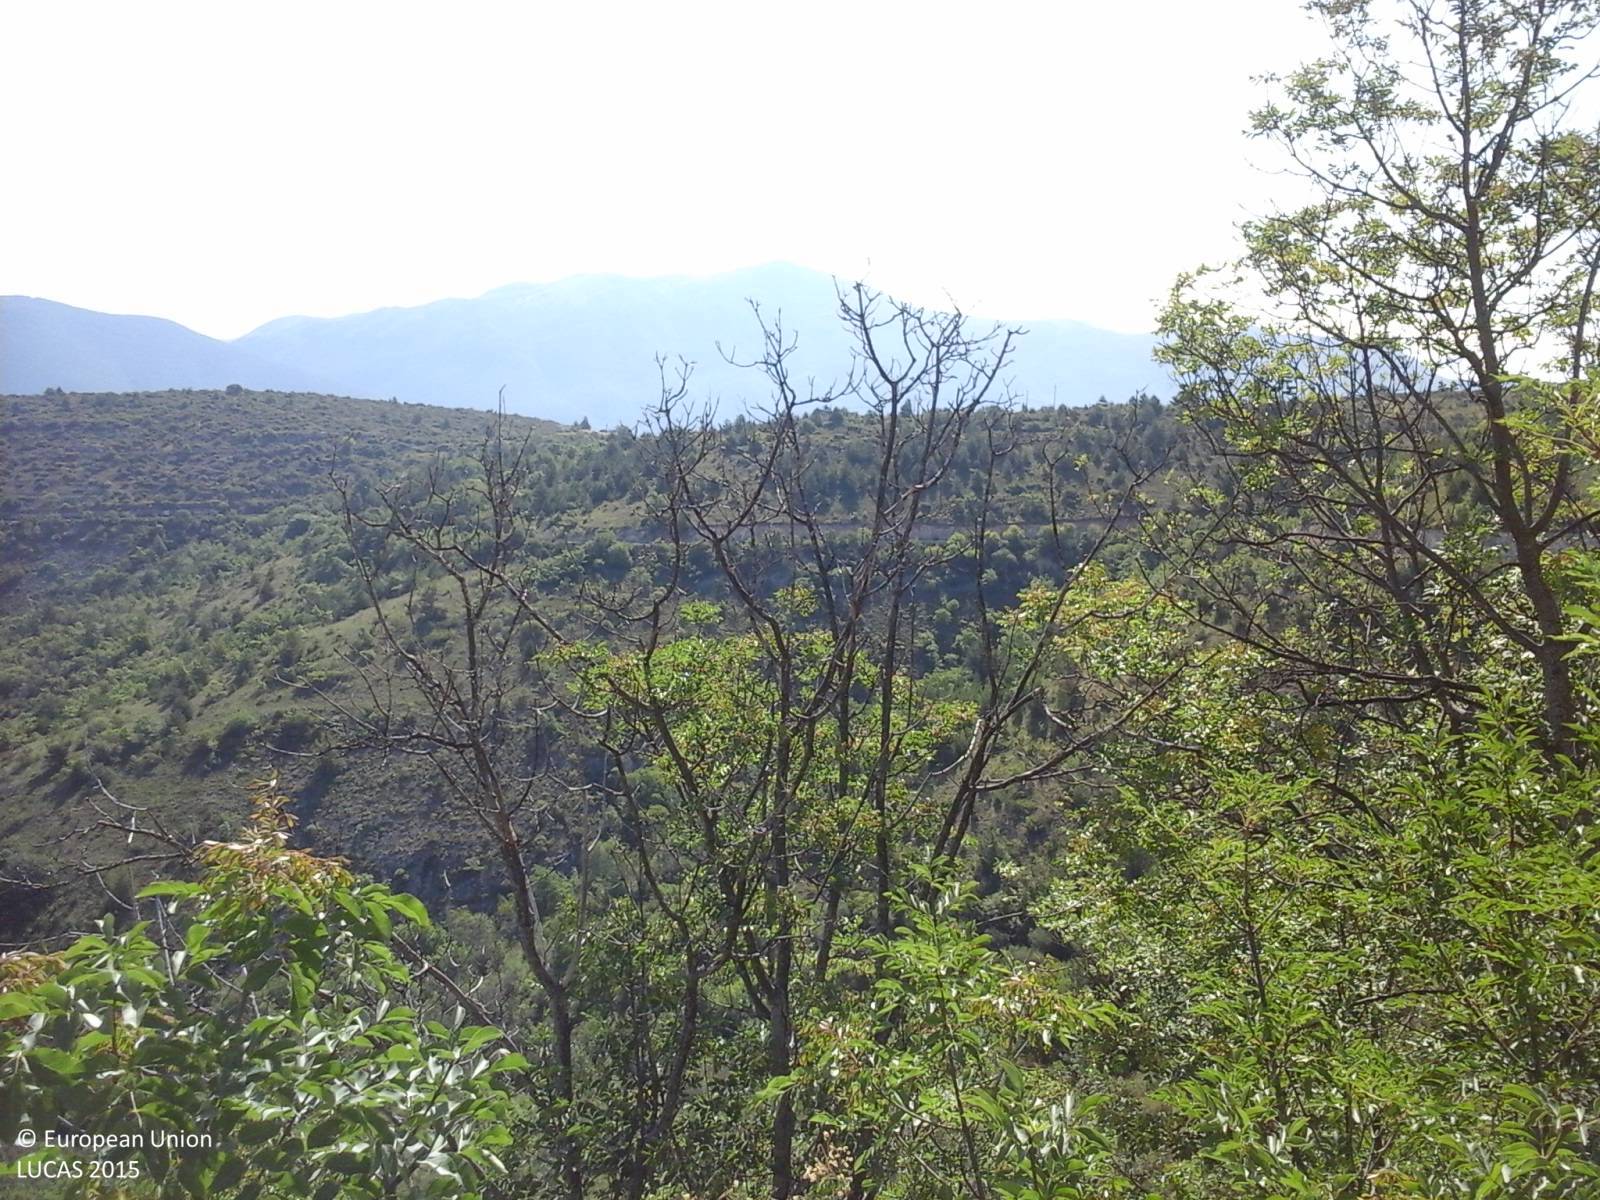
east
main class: Shrubland
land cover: Shrubland with sparse tree cover
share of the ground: > 75 %
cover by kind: herbaceous plants 60 %, shrubs 35 %, broadleaved forest trees 5 %
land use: Semi-natural and natural areas not in use
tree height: < 5 m
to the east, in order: Shrubland with sparse tree cover; Broadleaved woodland; Tracks; Broadleaved woodland; Tracks; Broadleaved woodland; Shrubland with sparse tree cover
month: June
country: IT
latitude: 42.2589
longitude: 13.7579
